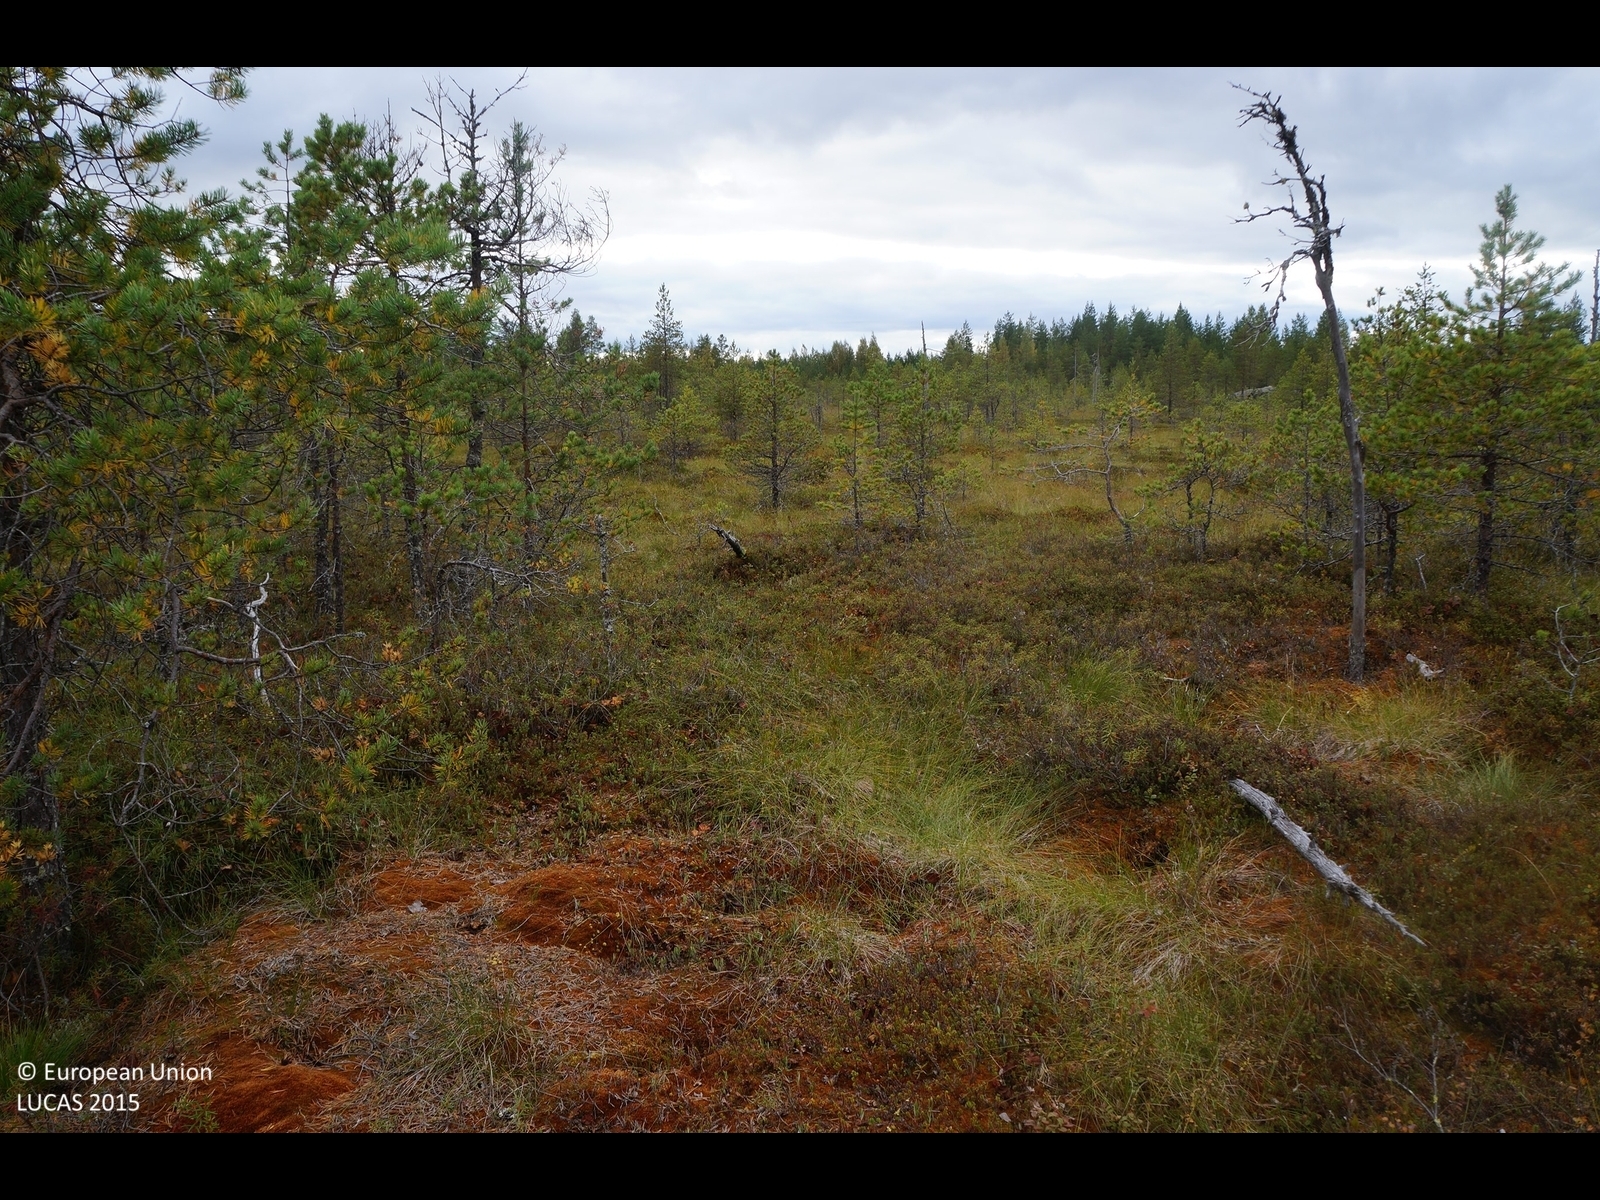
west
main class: Woodland
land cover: Pine dominated coniferous woodland
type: boreal forest
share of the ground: 25 - 50 %
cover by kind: shrubs 30 %, lichens and mosses 30 %, coniferous forest trees 25 %, herbaceous plants 15 %
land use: Semi-natural and natural areas not in use
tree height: < 5 m
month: September
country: FI
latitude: 64.0200
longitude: 24.1237
